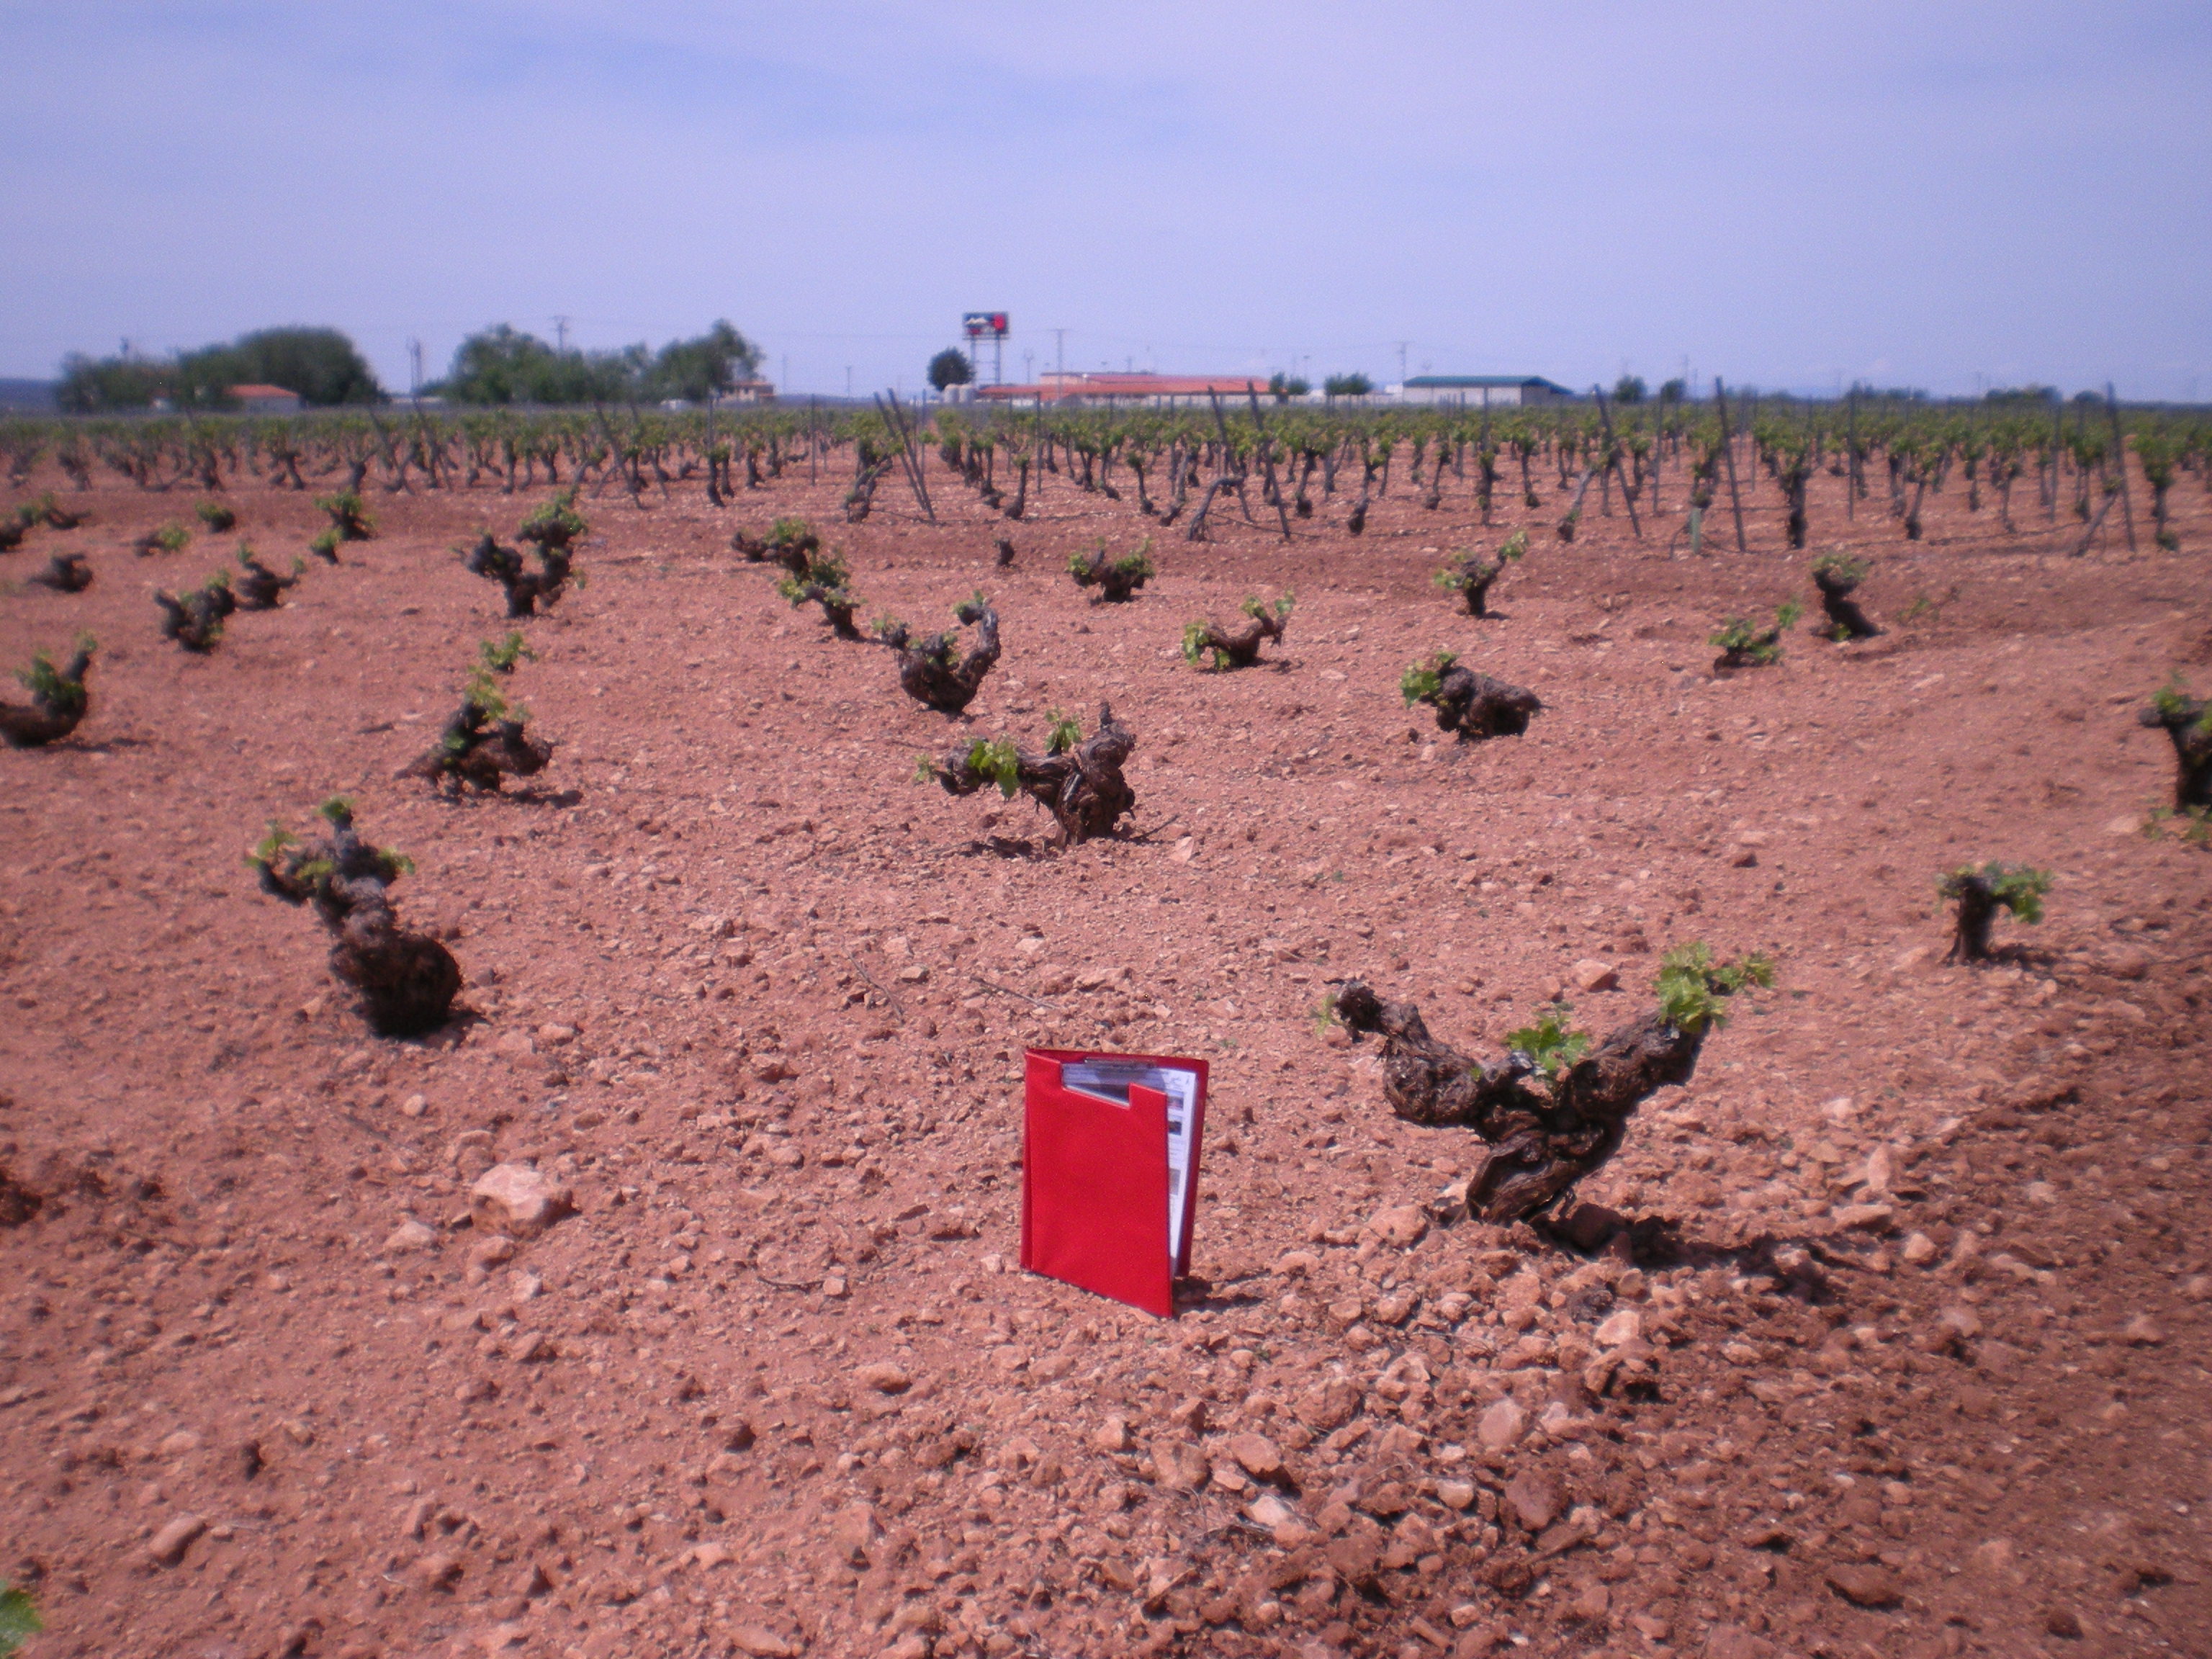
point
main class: Cropland
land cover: Vineyards
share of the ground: < 10 %
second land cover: Other bare soil
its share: > 75 %
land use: Agriculture (excluding fallow land and kitchen gardens)
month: May
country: ES
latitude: 38.8503
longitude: -3.3899
